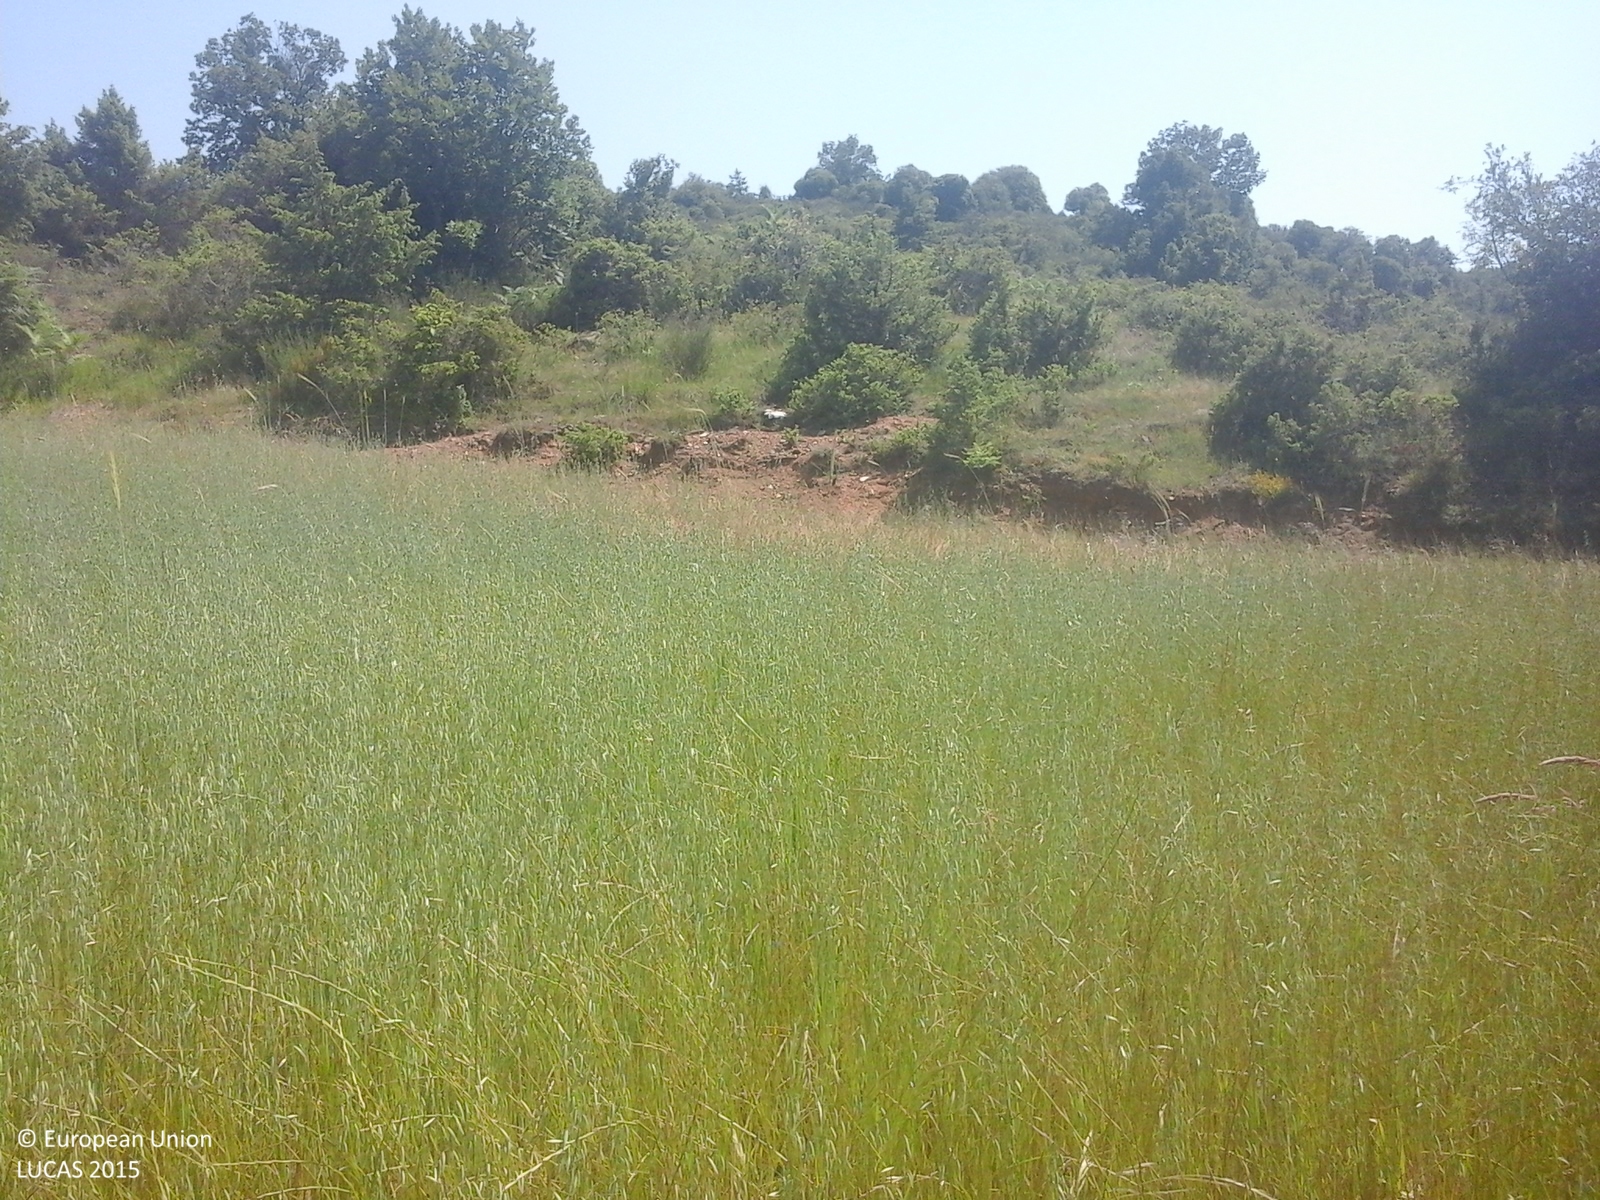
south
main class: Woodland
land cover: Broadleaved woodland
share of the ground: > 75 %
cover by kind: broadleaved forest trees 80 %, shrubs 20 %
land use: Semi-natural and natural areas not in use
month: June
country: GR
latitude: 40.5637
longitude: 23.1783
